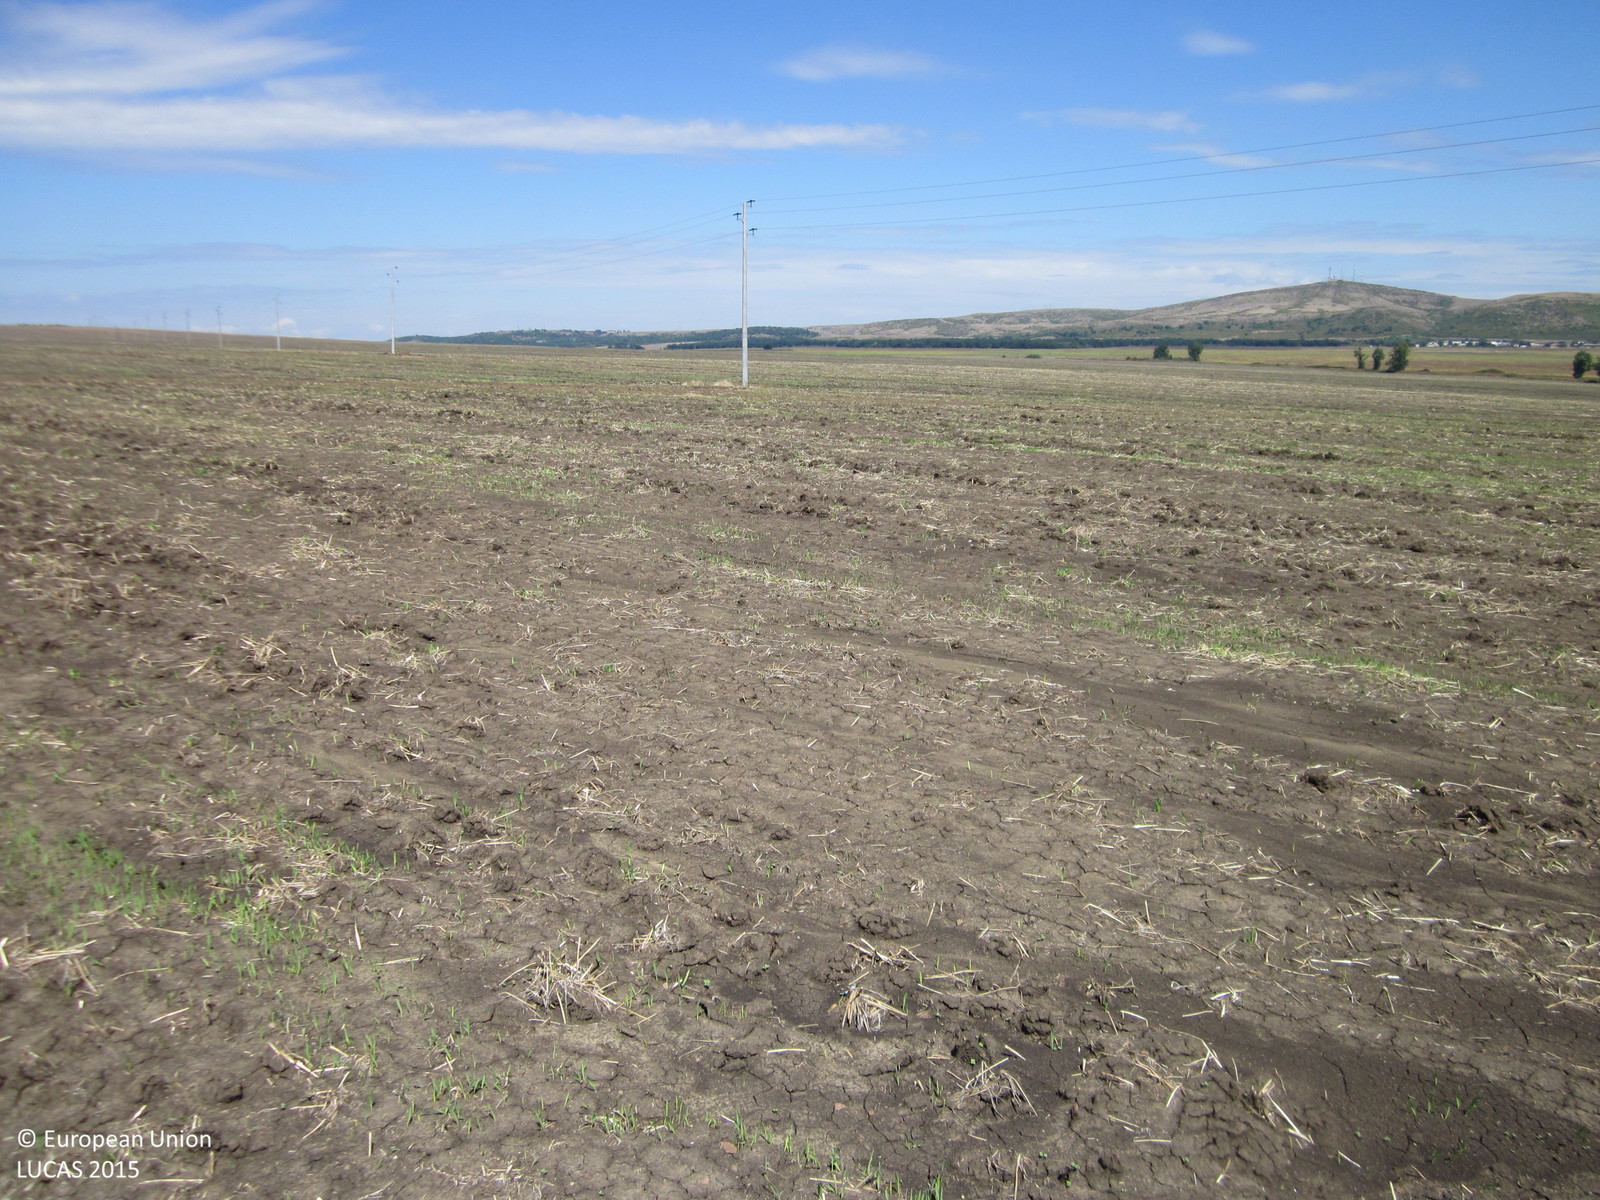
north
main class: Cropland
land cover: Common wheat
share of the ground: < 10 %
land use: Agriculture (excluding fallow land and kitchen gardens)
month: August
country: BG
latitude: 42.5925
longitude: 26.9587
